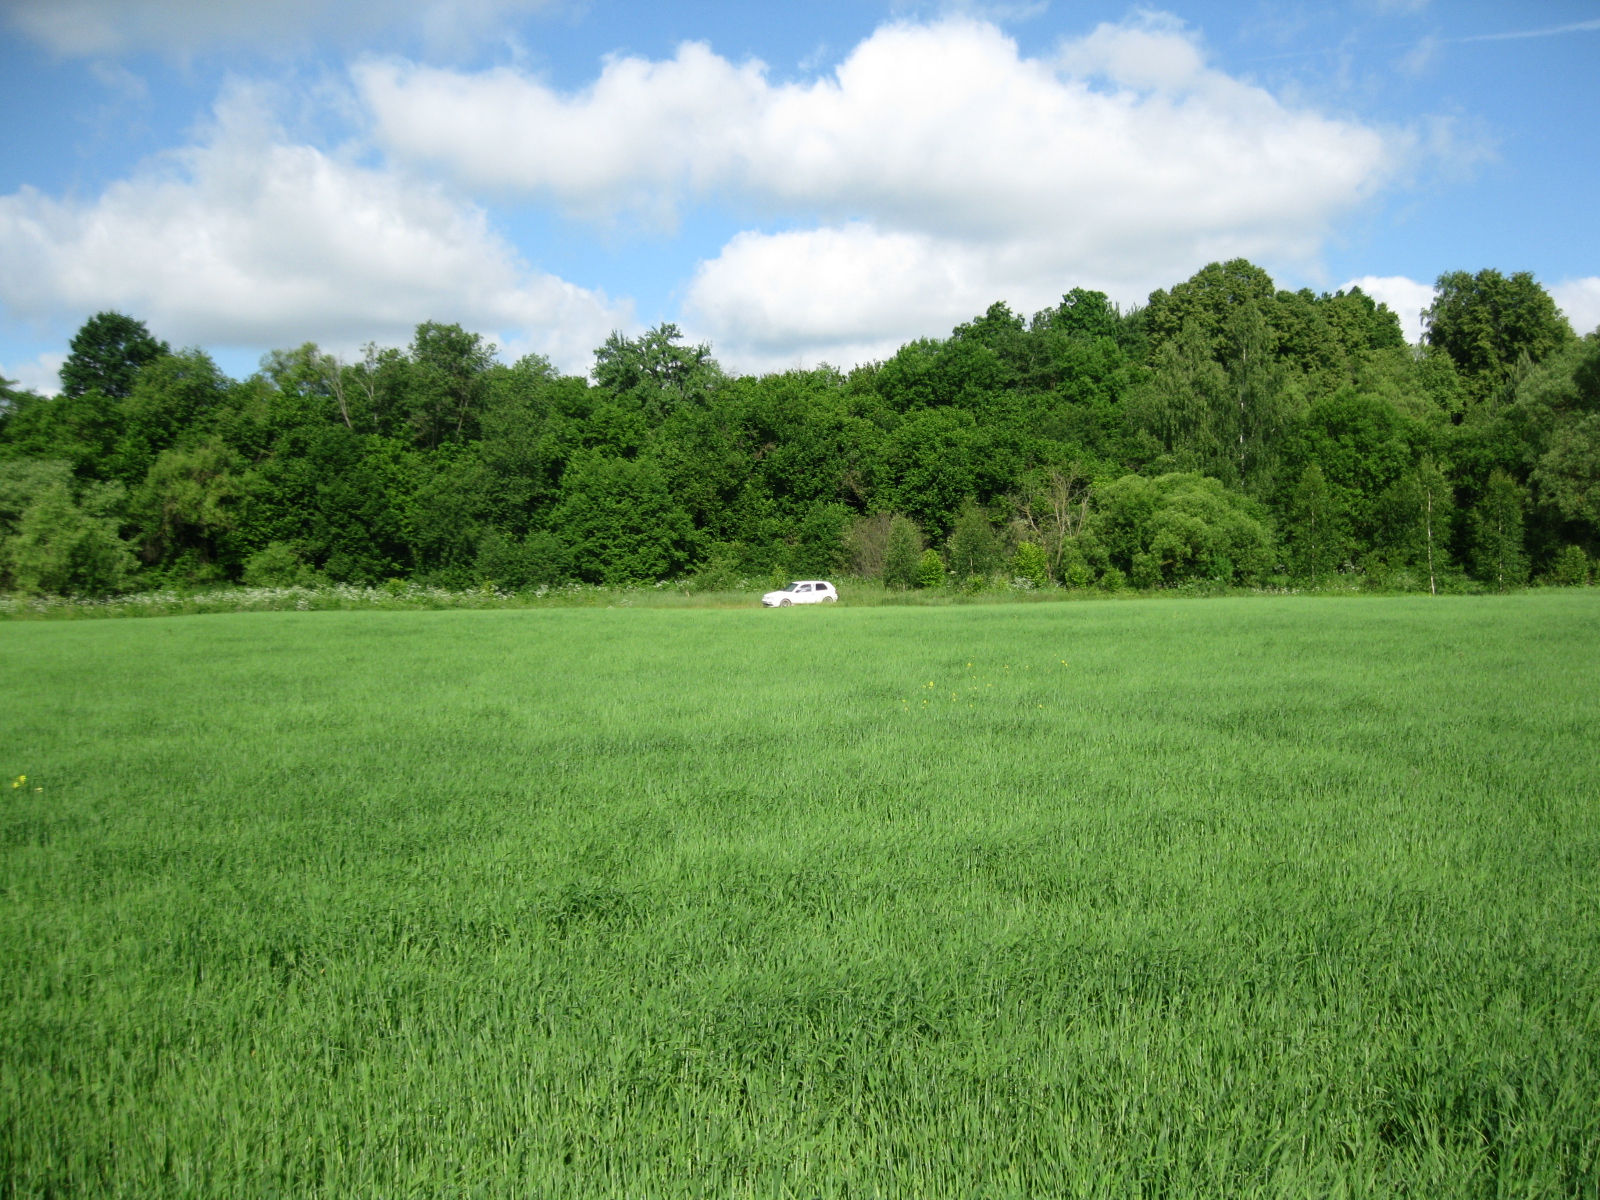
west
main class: Cropland
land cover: Barley
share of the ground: > 75 %
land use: Agriculture (excluding fallow land and kitchen gardens)
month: June
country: LT
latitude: 55.1785
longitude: 23.8266
